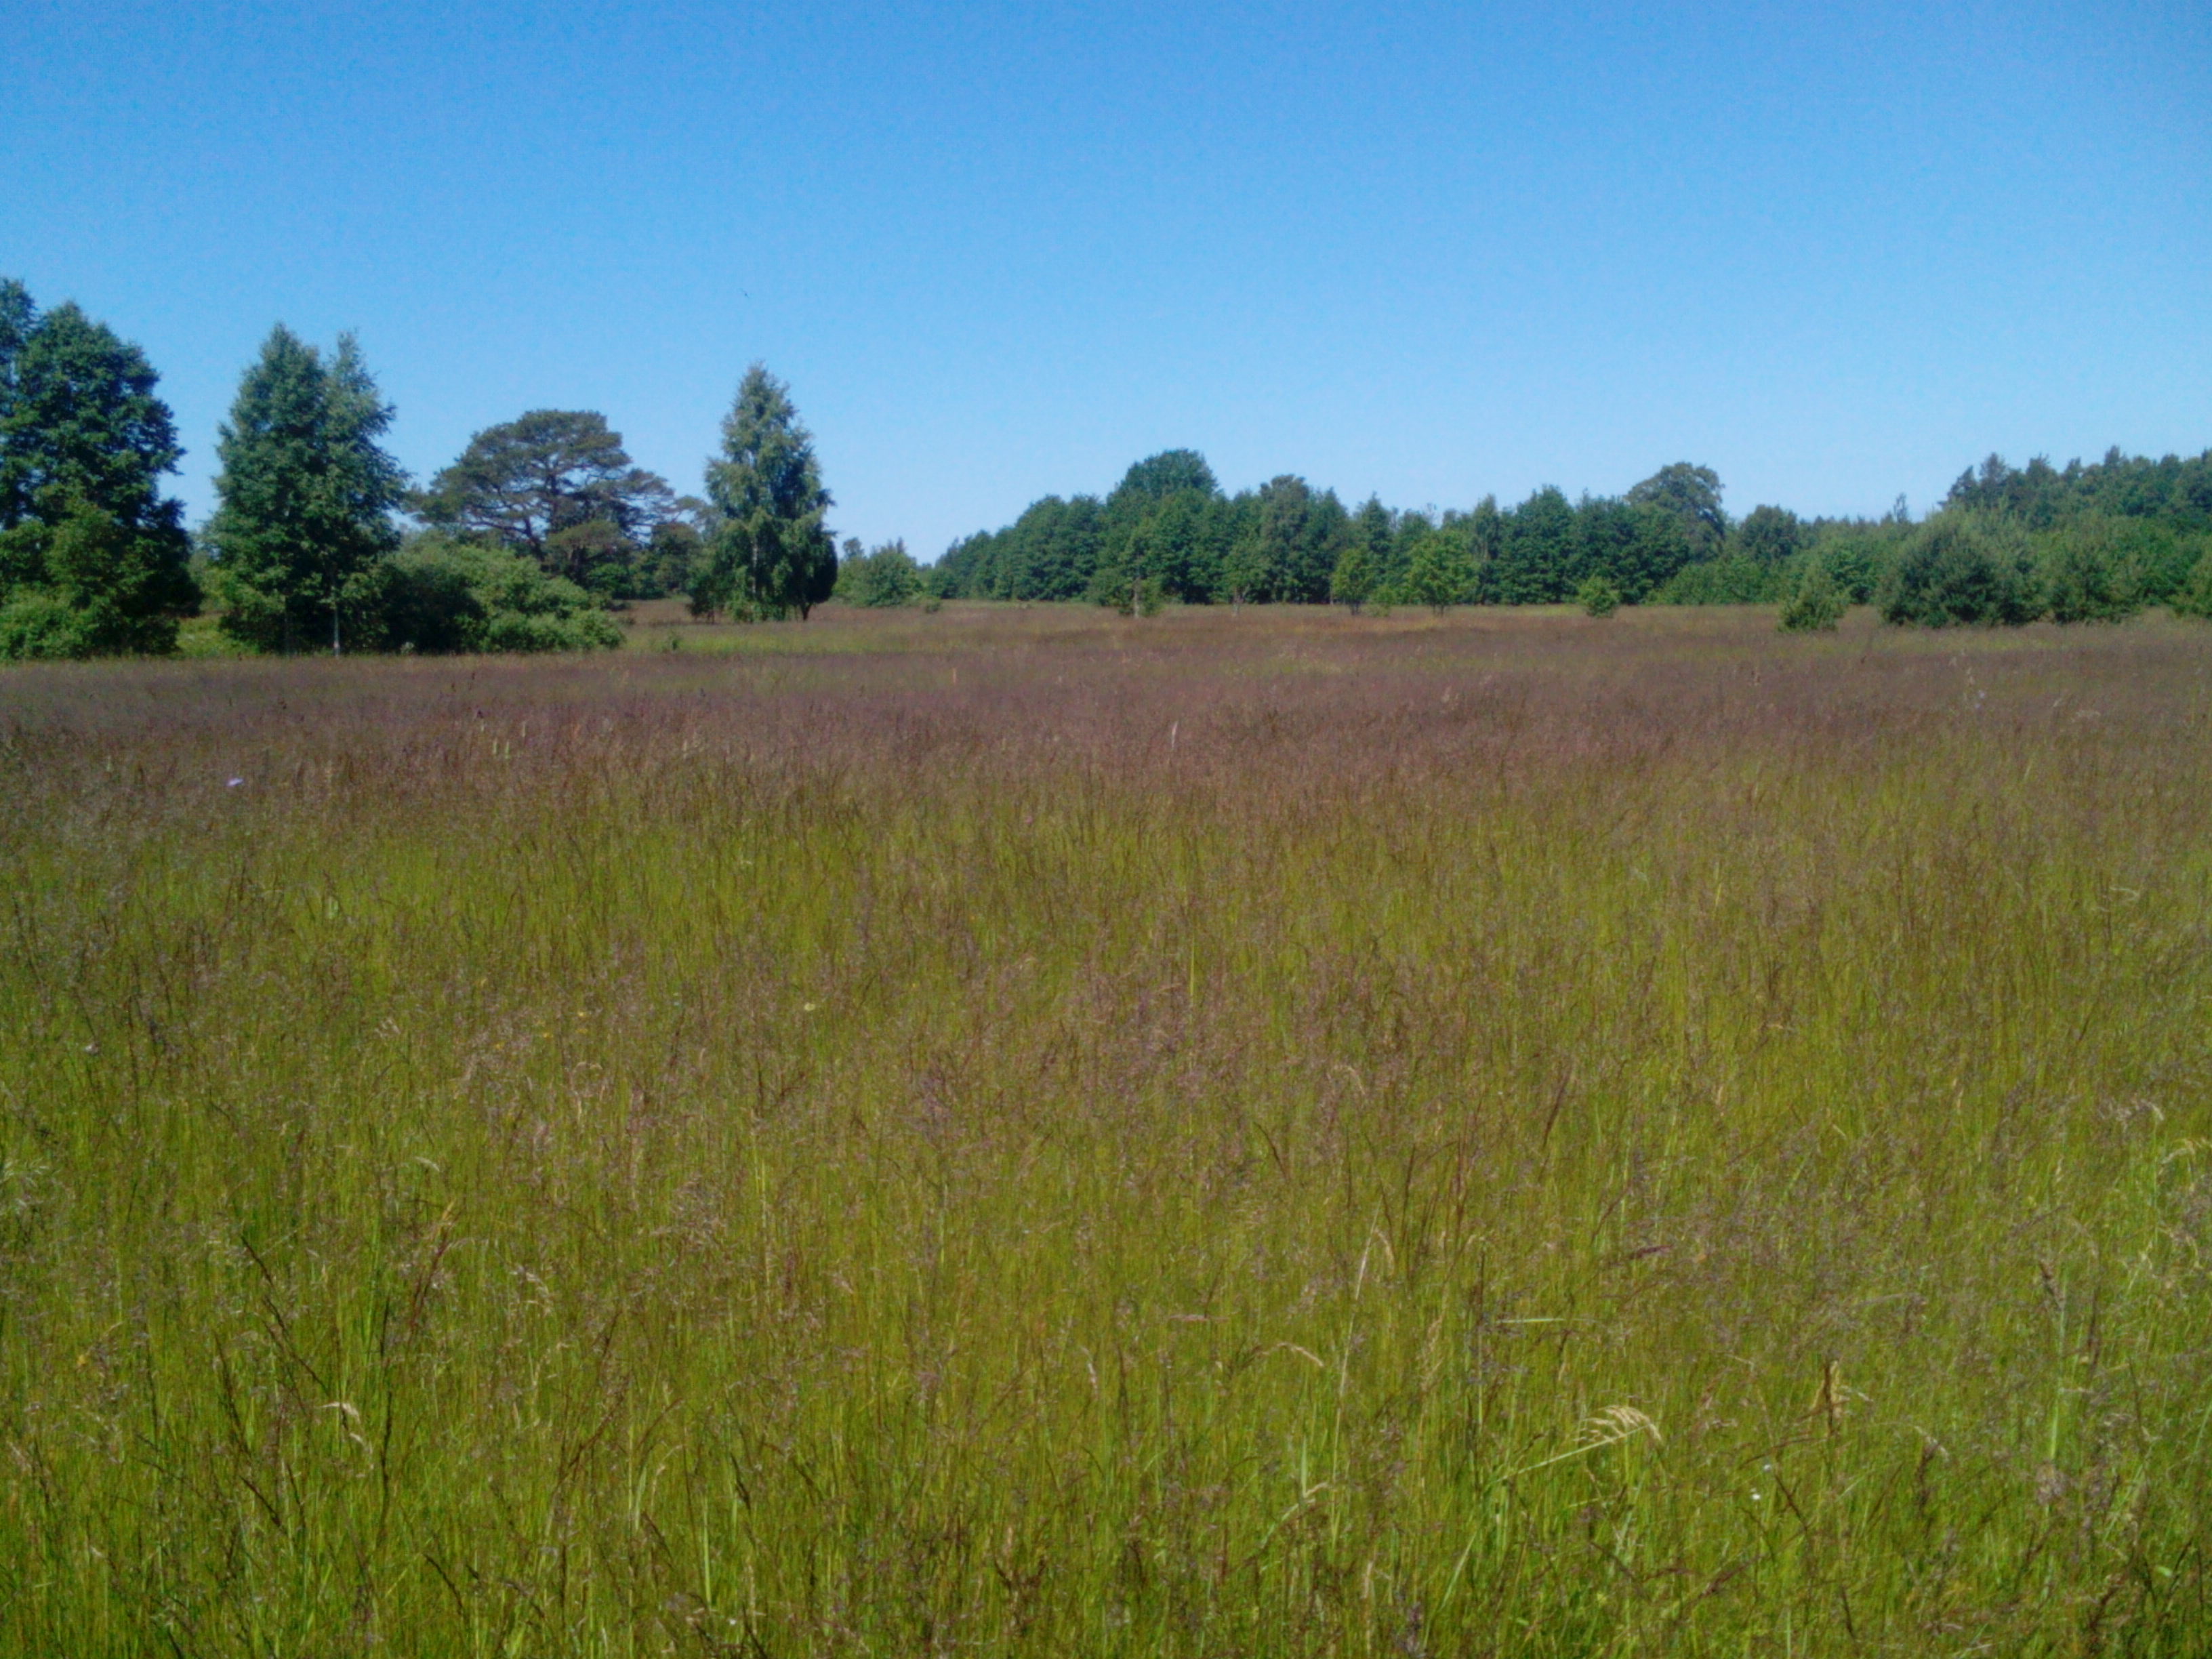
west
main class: Grassland
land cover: Grassland without tree/shrub cover
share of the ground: > 75 %
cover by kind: herbaceous plants 100 %
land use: Agriculture (excluding fallow land and kitchen gardens)
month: June
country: LV
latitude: 56.9087
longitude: 21.2539
